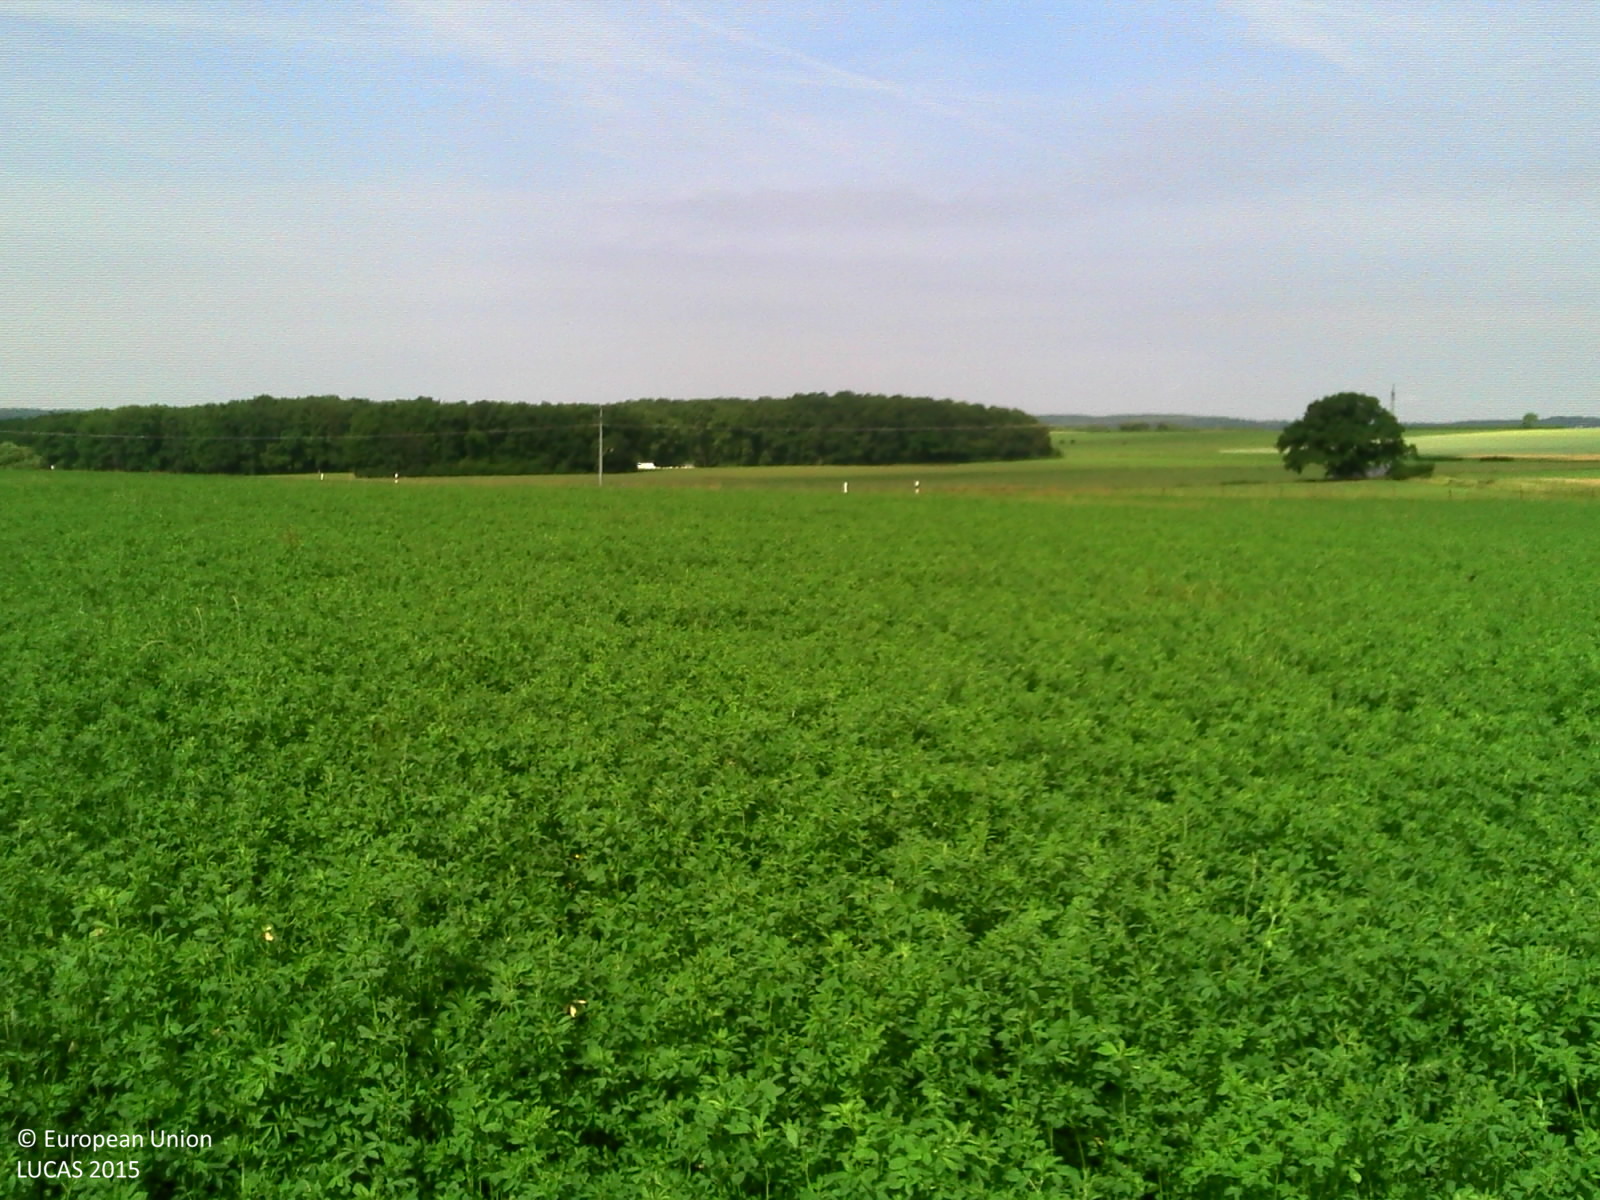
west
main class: Cropland
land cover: Common wheat
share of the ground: > 75 %
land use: Agriculture (excluding fallow land and kitchen gardens)
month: June
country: LU
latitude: 49.7810
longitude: 6.2637
